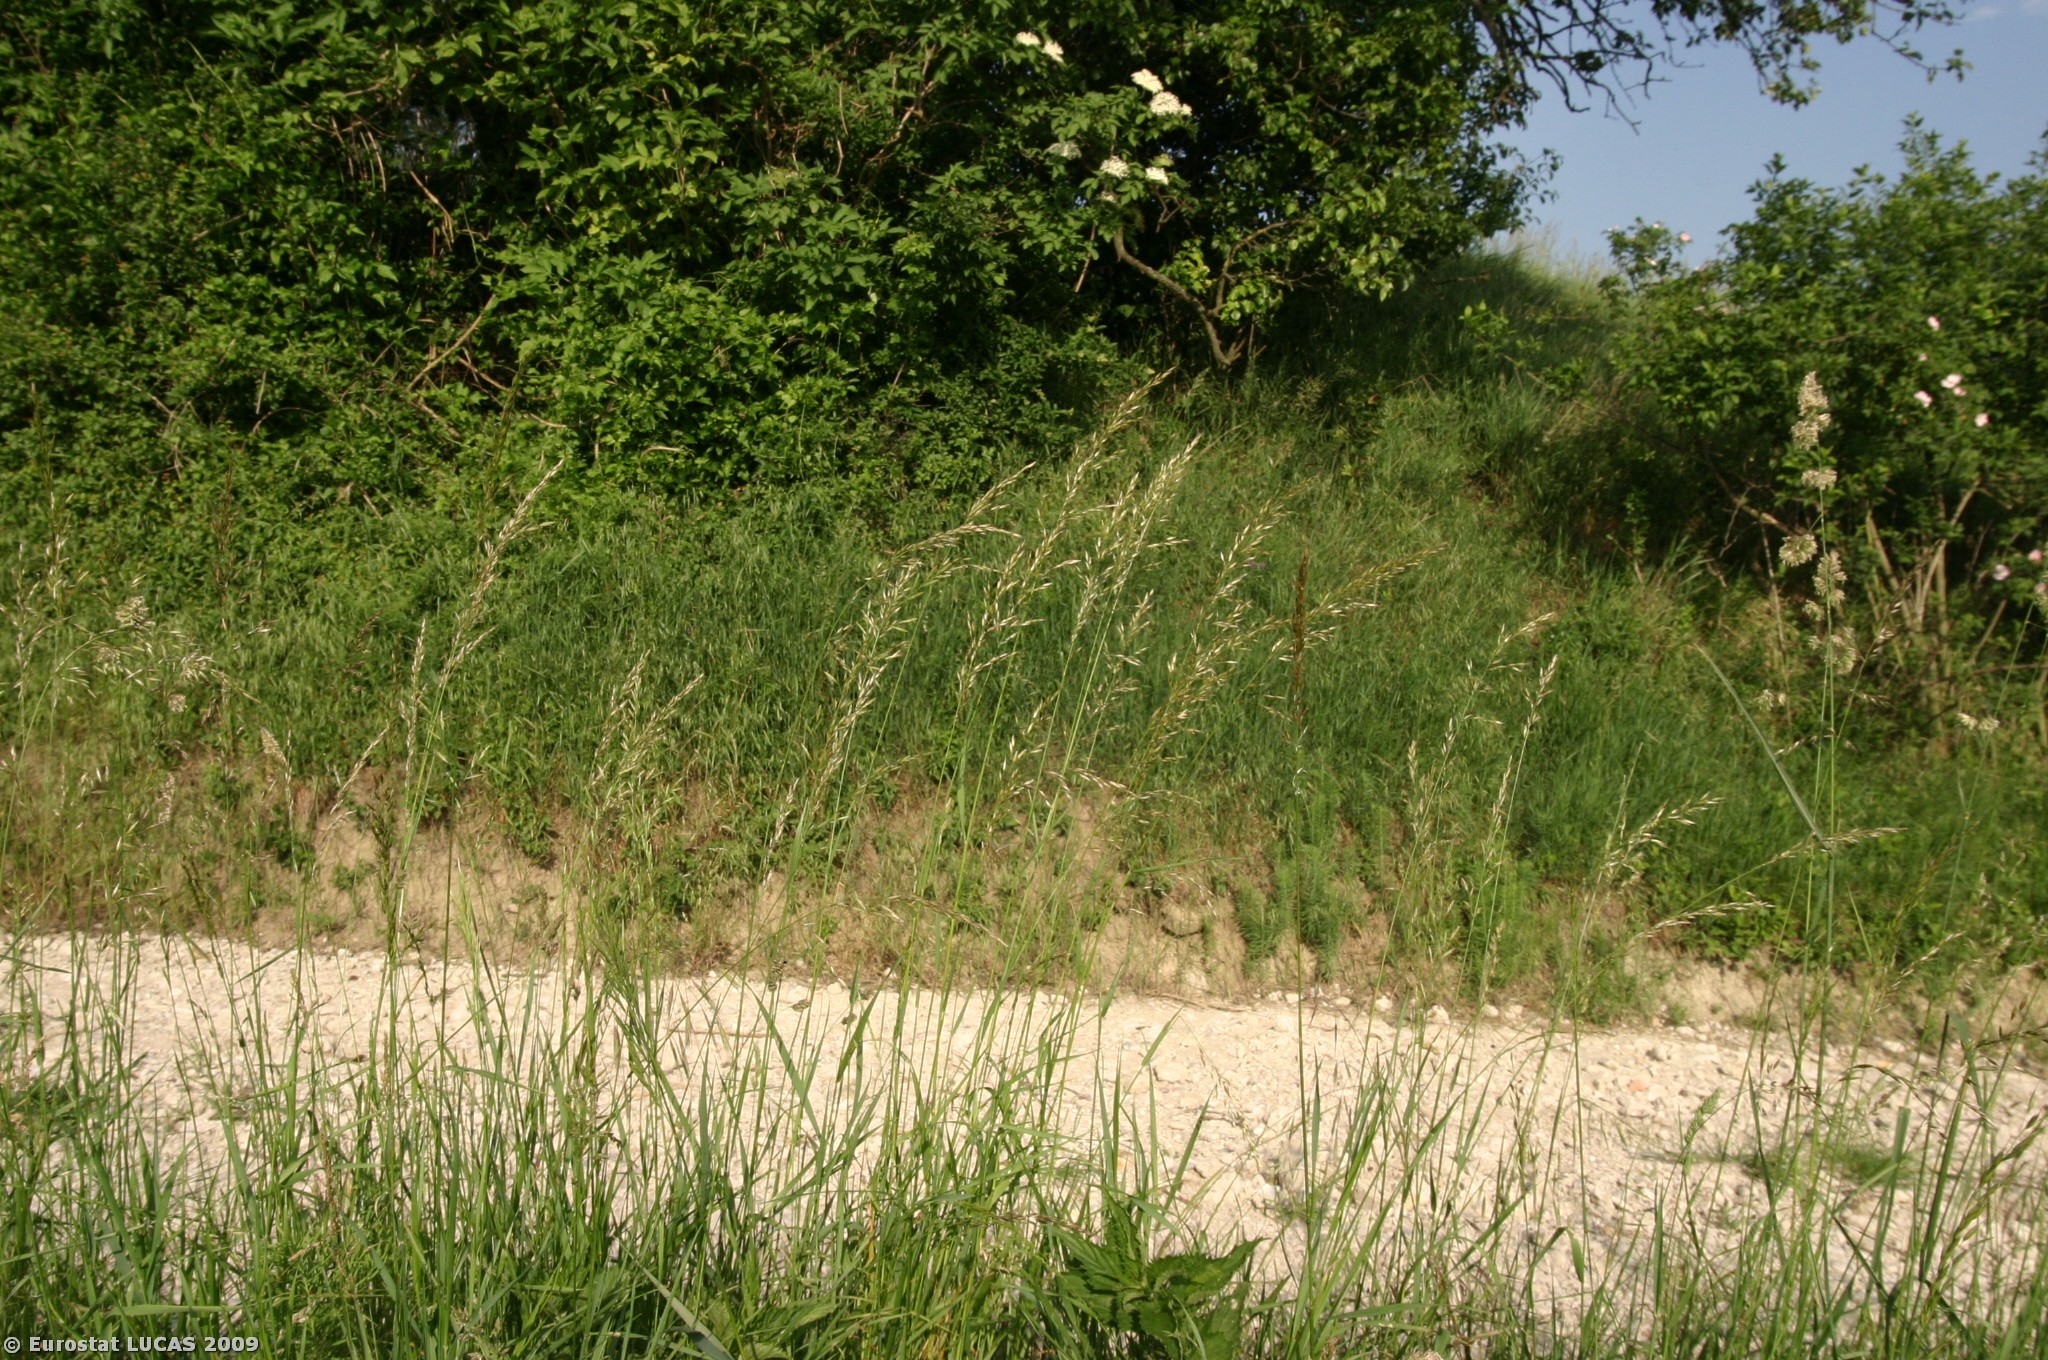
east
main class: Cropland
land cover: Triticale
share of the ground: > 75 %
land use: Agriculture (excluding fallow land and kitchen gardens)
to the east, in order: Triticale; Grass margins; Tracks; Abandoned hedges; Grassland without tree/shrub cover; Groves; Broadleaved woodland; Coniferous woodland; Mixed woodland; Coniferous woodland
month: May
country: AT
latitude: 48.2408
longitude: 15.9958
